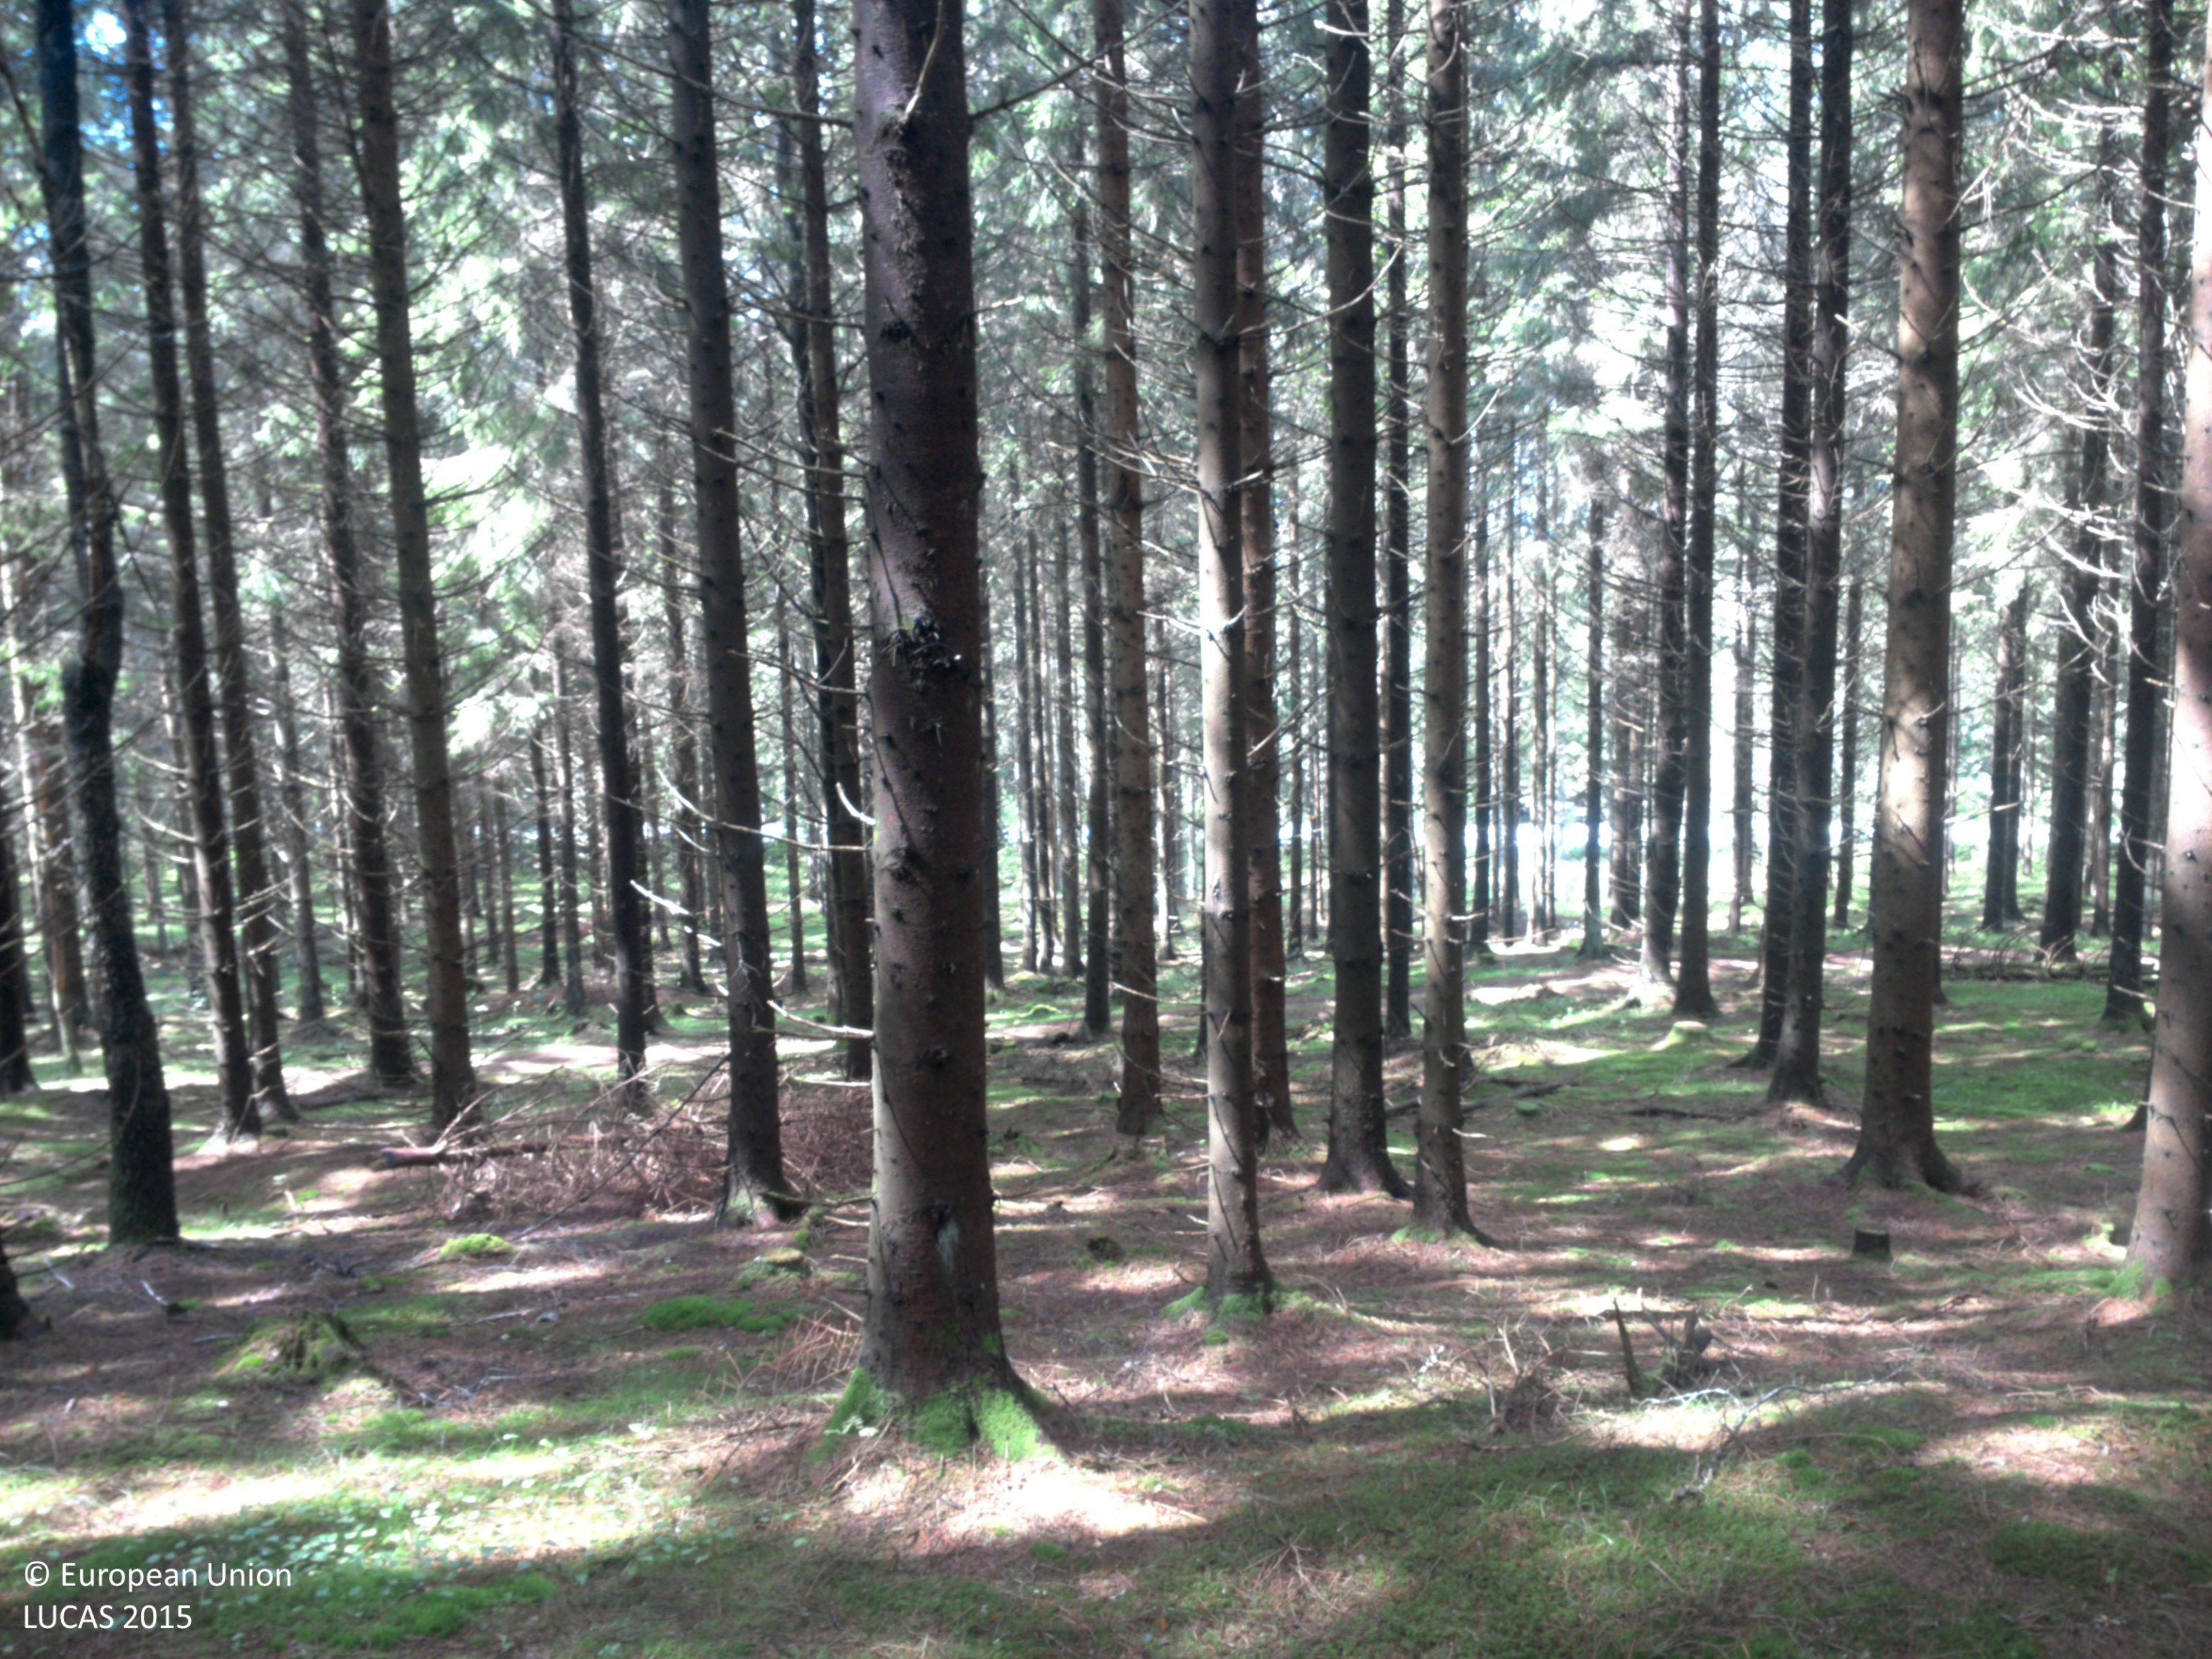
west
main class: Woodland
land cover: Spruce dominated coniferous woodland
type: boreal forest
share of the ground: 50 - 75 %
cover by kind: coniferous forest trees 75 %, lichens and mosses 25 %
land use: Forestry
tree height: > 5 m
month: July
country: SE
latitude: 58.0969
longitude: 11.9812
